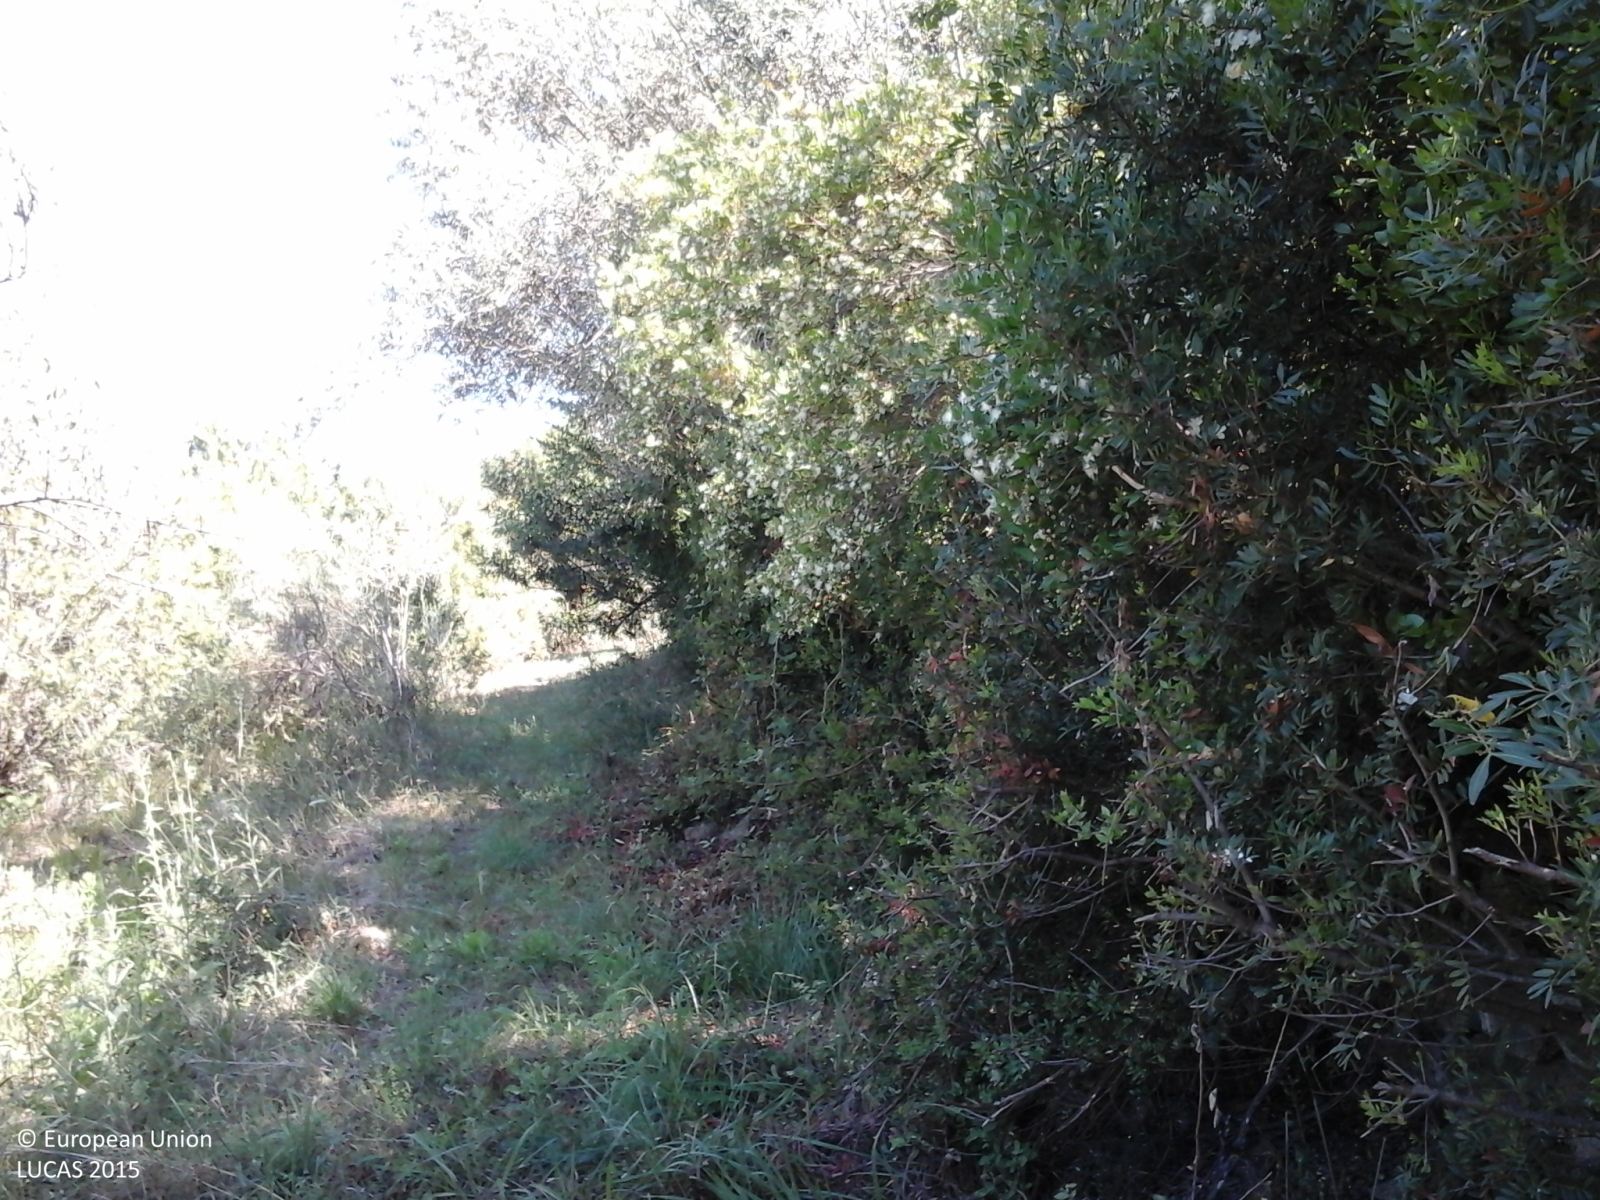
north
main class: Cropland
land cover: Olive groves
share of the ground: > 75 %
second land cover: Spontaneously vegetated surfaces
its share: > 75 %
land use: Kitchen garden
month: June
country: IT
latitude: 40.3715
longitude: 15.0775
